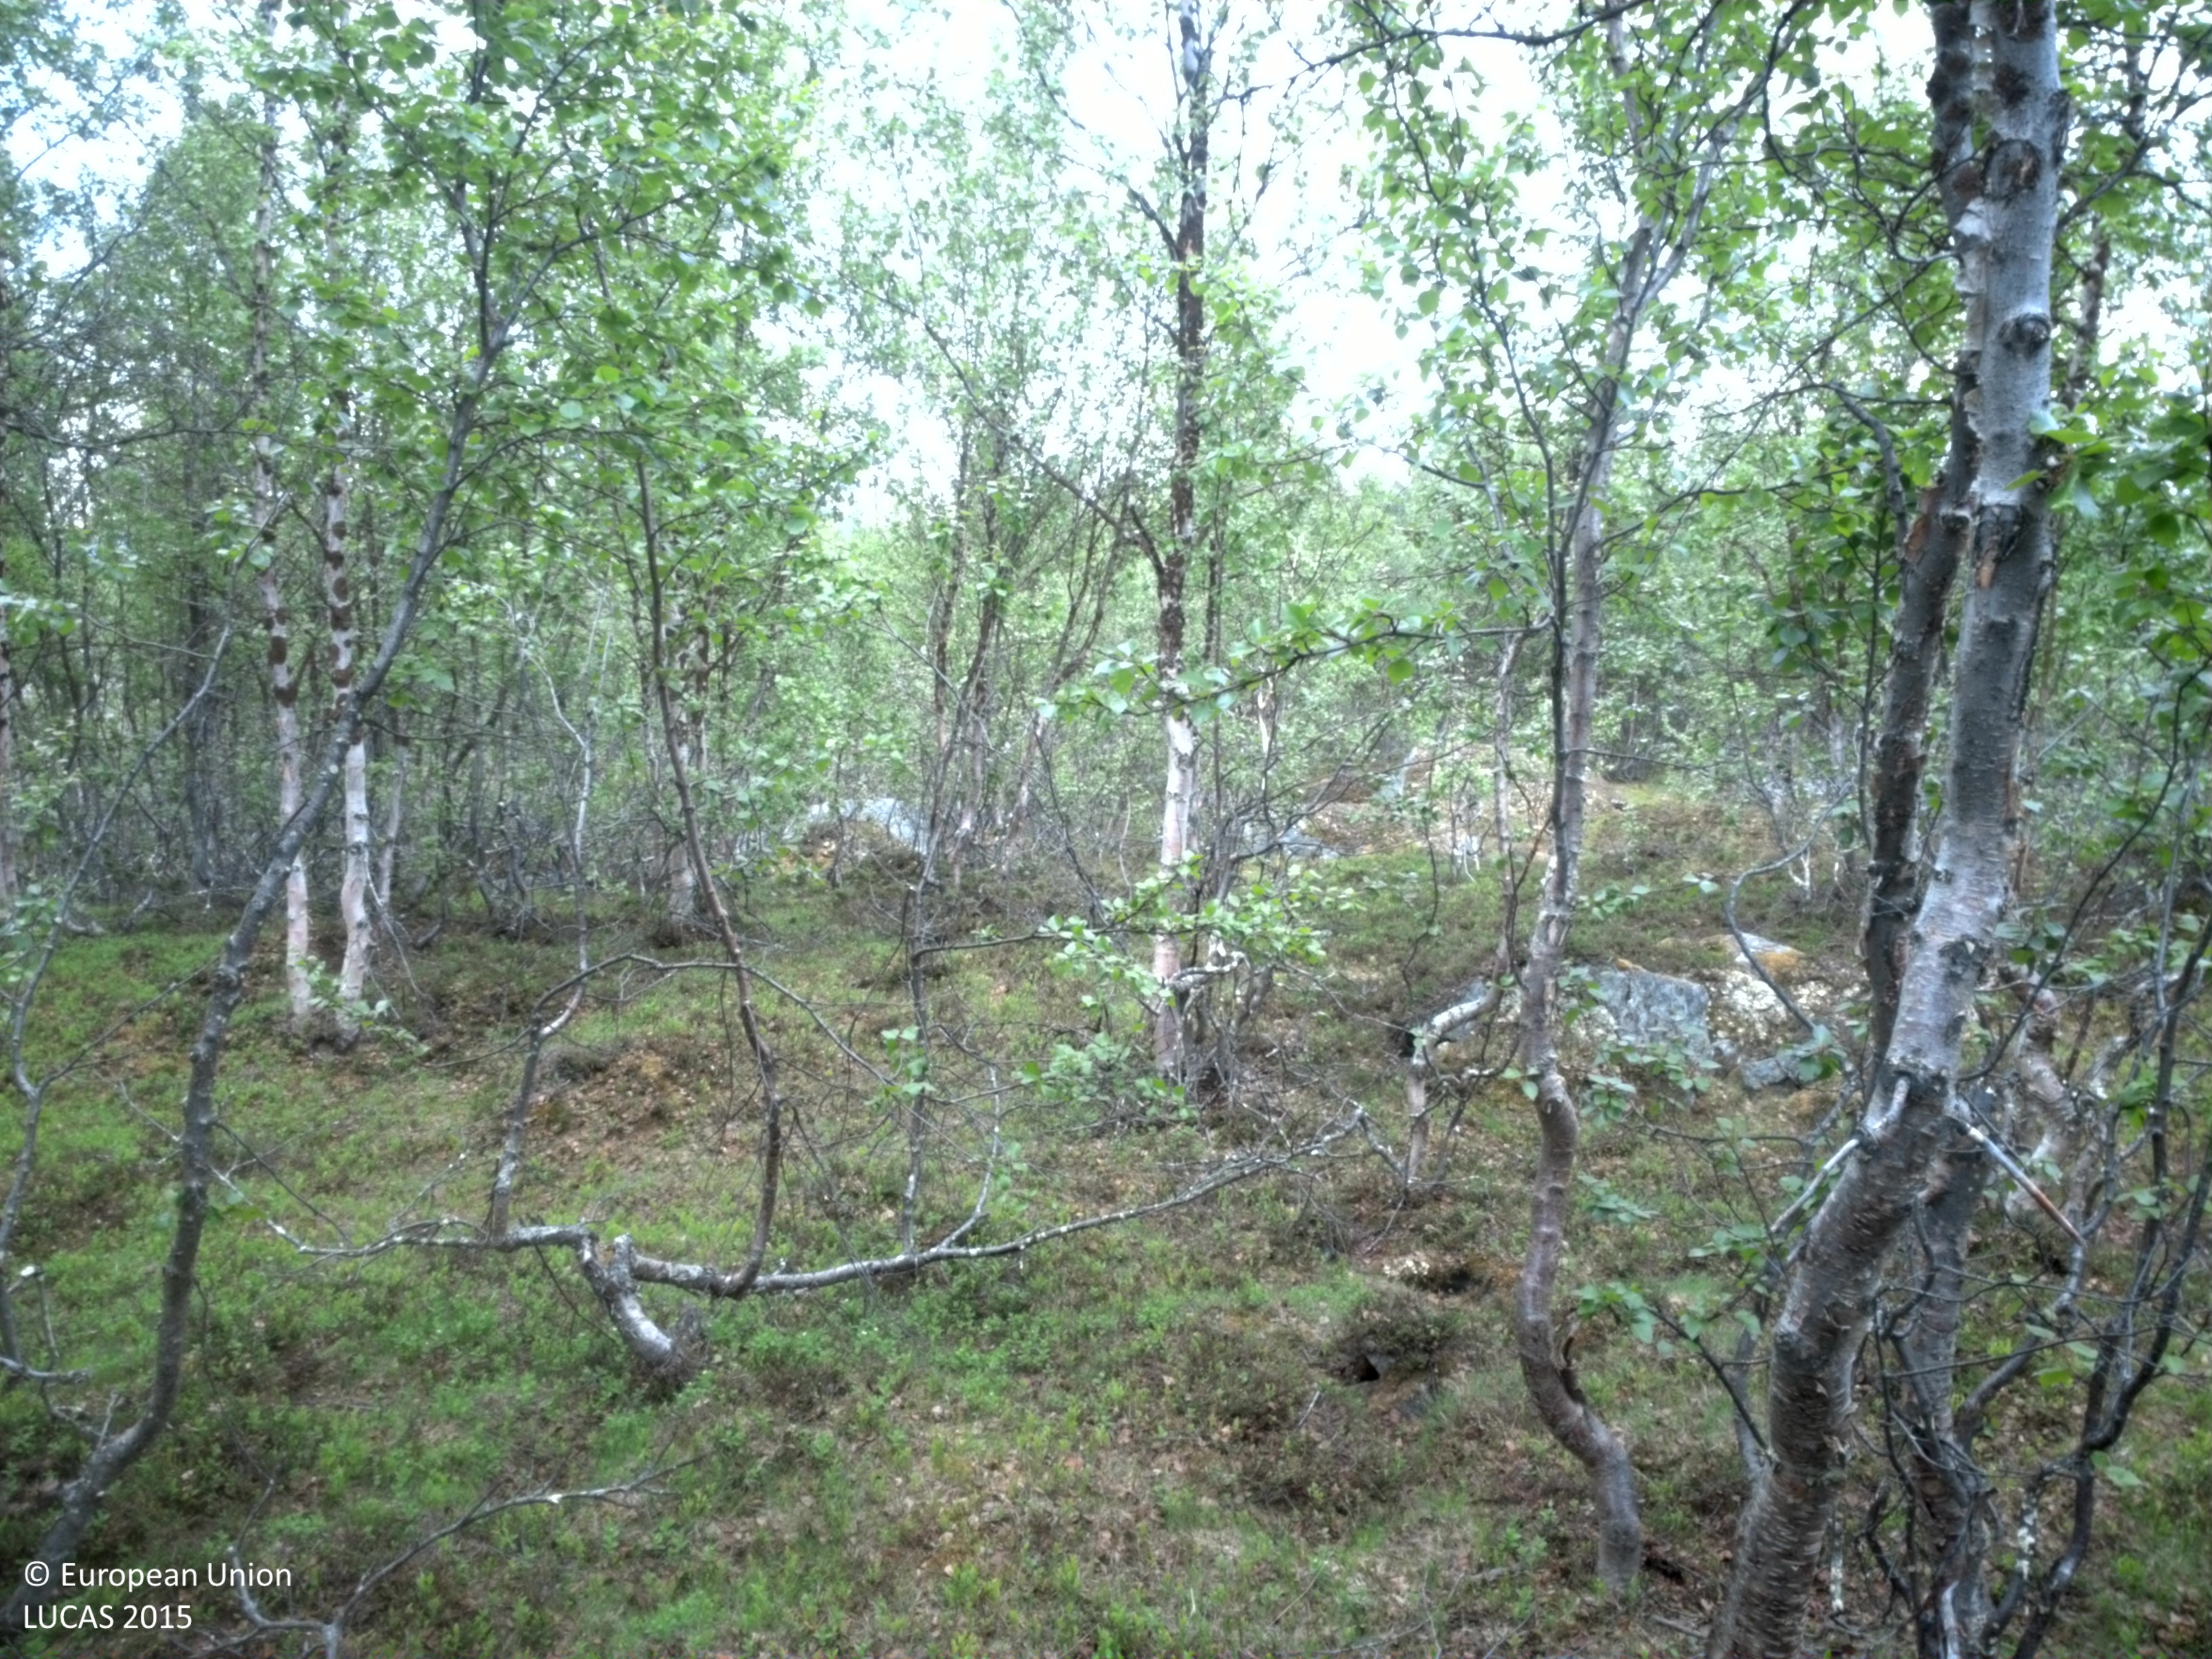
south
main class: Woodland
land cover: Broadleaved woodland
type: non-riverine alder, birch or aspen forest
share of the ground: 50 - 75 %
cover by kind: broadleaved forest trees 60 %, shrubs 35 %, lichens and mosses 5 %
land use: Amenities, museums, leisure
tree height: < 5 m
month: July
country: SE
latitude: 67.7305
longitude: 17.4843
